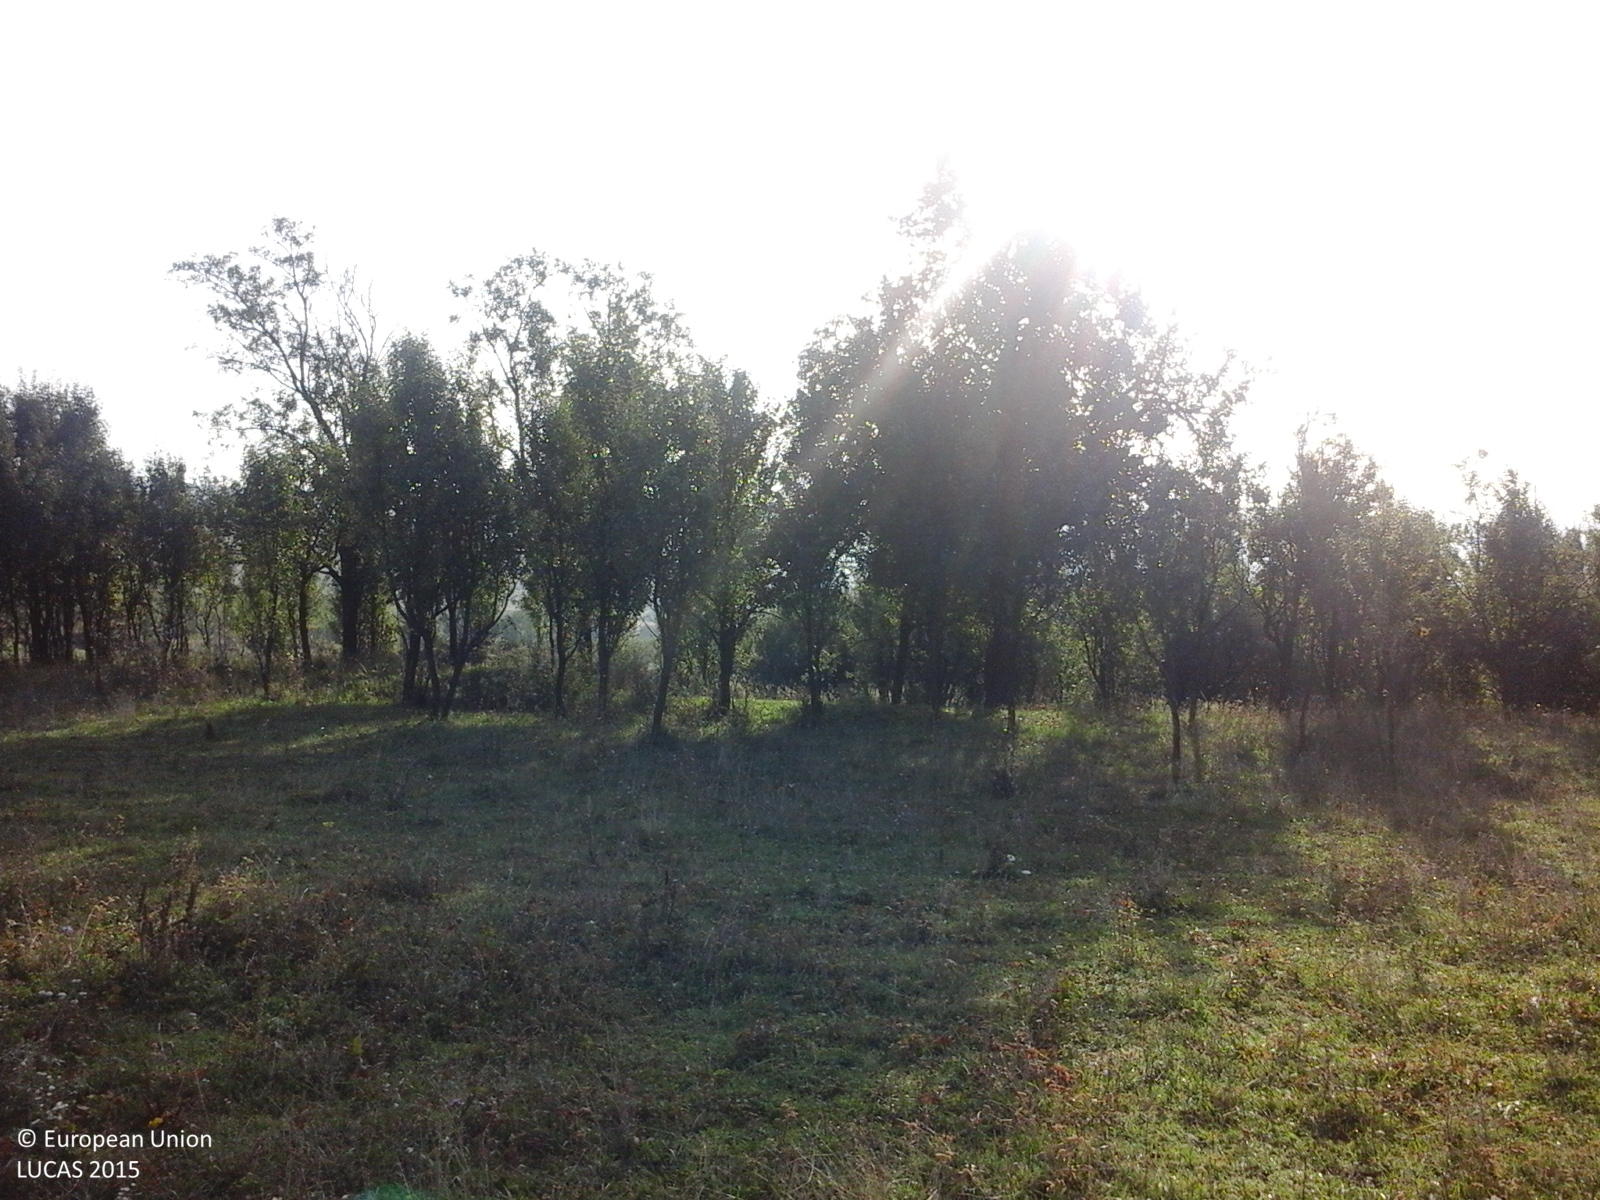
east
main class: Grassland
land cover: Grassland without tree/shrub cover
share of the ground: > 75 %
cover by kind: herbaceous plants 100 %
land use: Agriculture (excluding fallow land and kitchen gardens)
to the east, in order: Grassland without tree/shrub cover; Other fruit trees and berries; Spontaneously vegetated surfaces; Grassland without tree/shrub cover; Grass margins; Grassland without tree/shrub cover
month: September
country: RO
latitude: 47.0320
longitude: 23.7209
